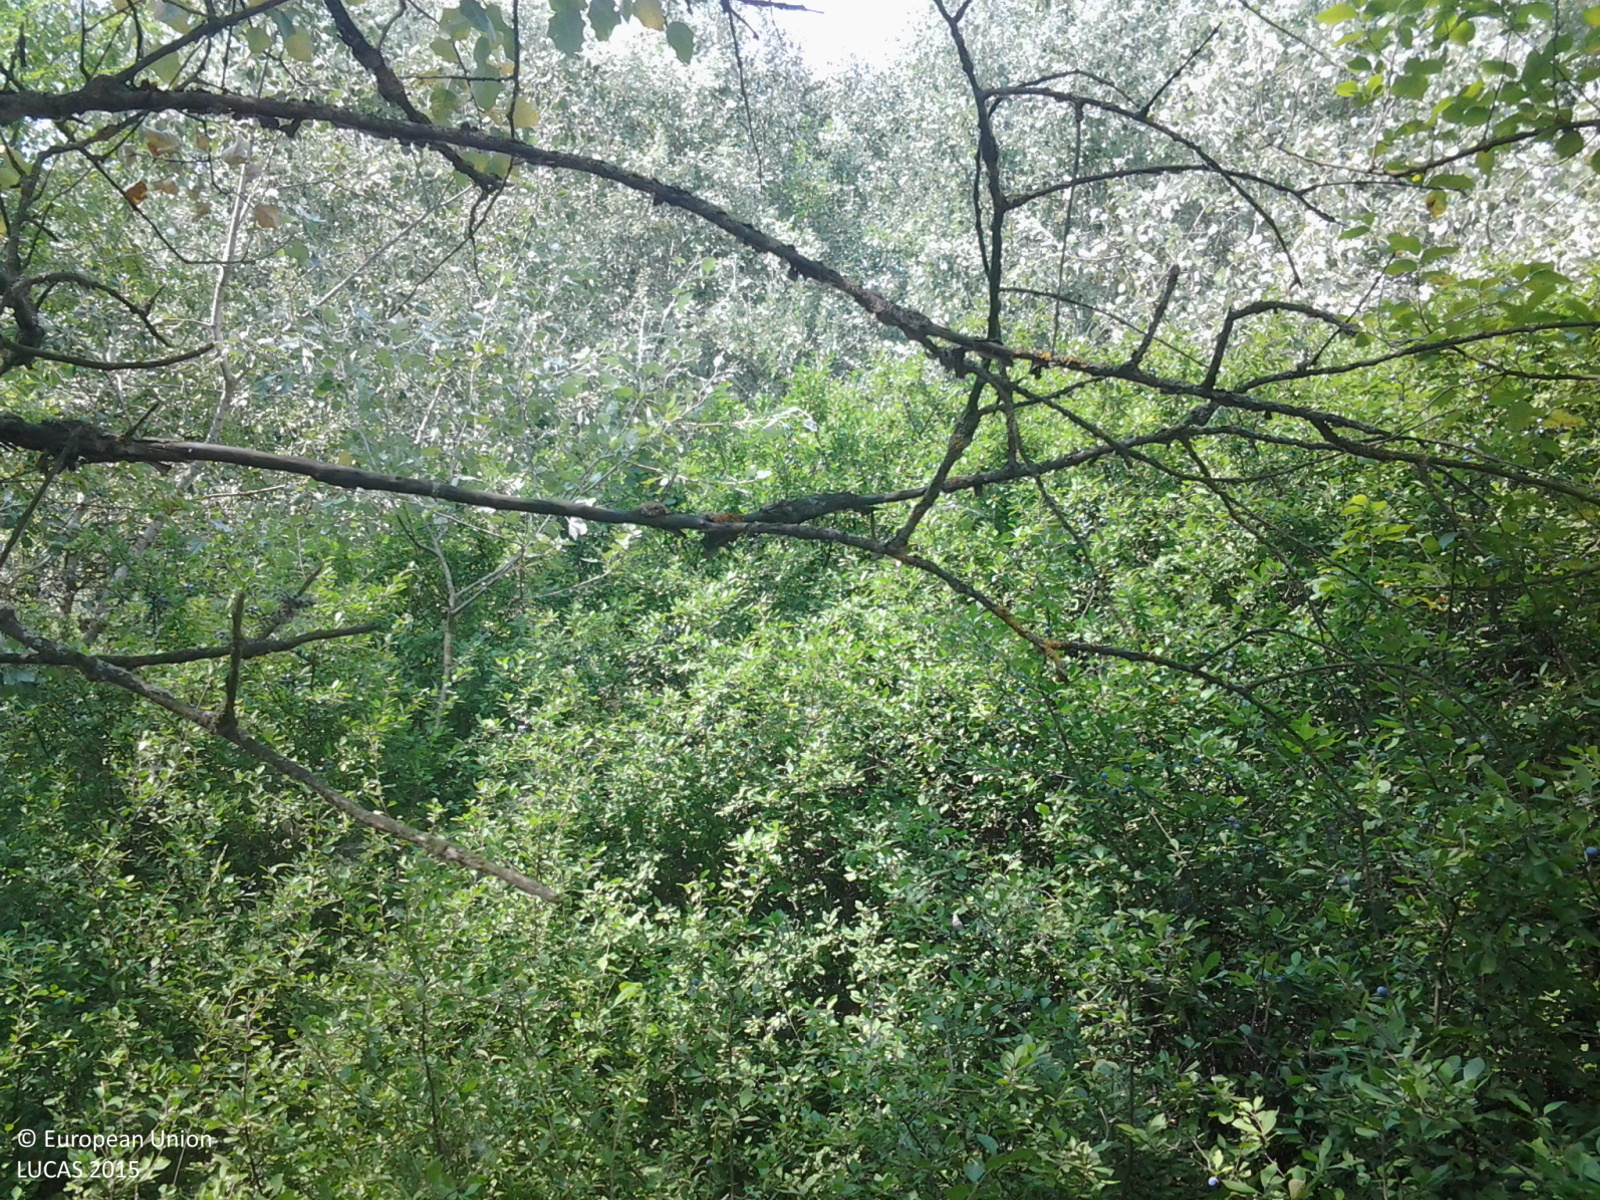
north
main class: Woodland
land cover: Broadleaved woodland
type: non-riverine alder, birch or aspen forest
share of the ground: > 75 %
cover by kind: broadleaved forest trees 75 %, herbaceous plants 15 %, shrubs 10 %
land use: Forestry
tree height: > 5 m
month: July
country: HU
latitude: 46.8366
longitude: 21.5121
